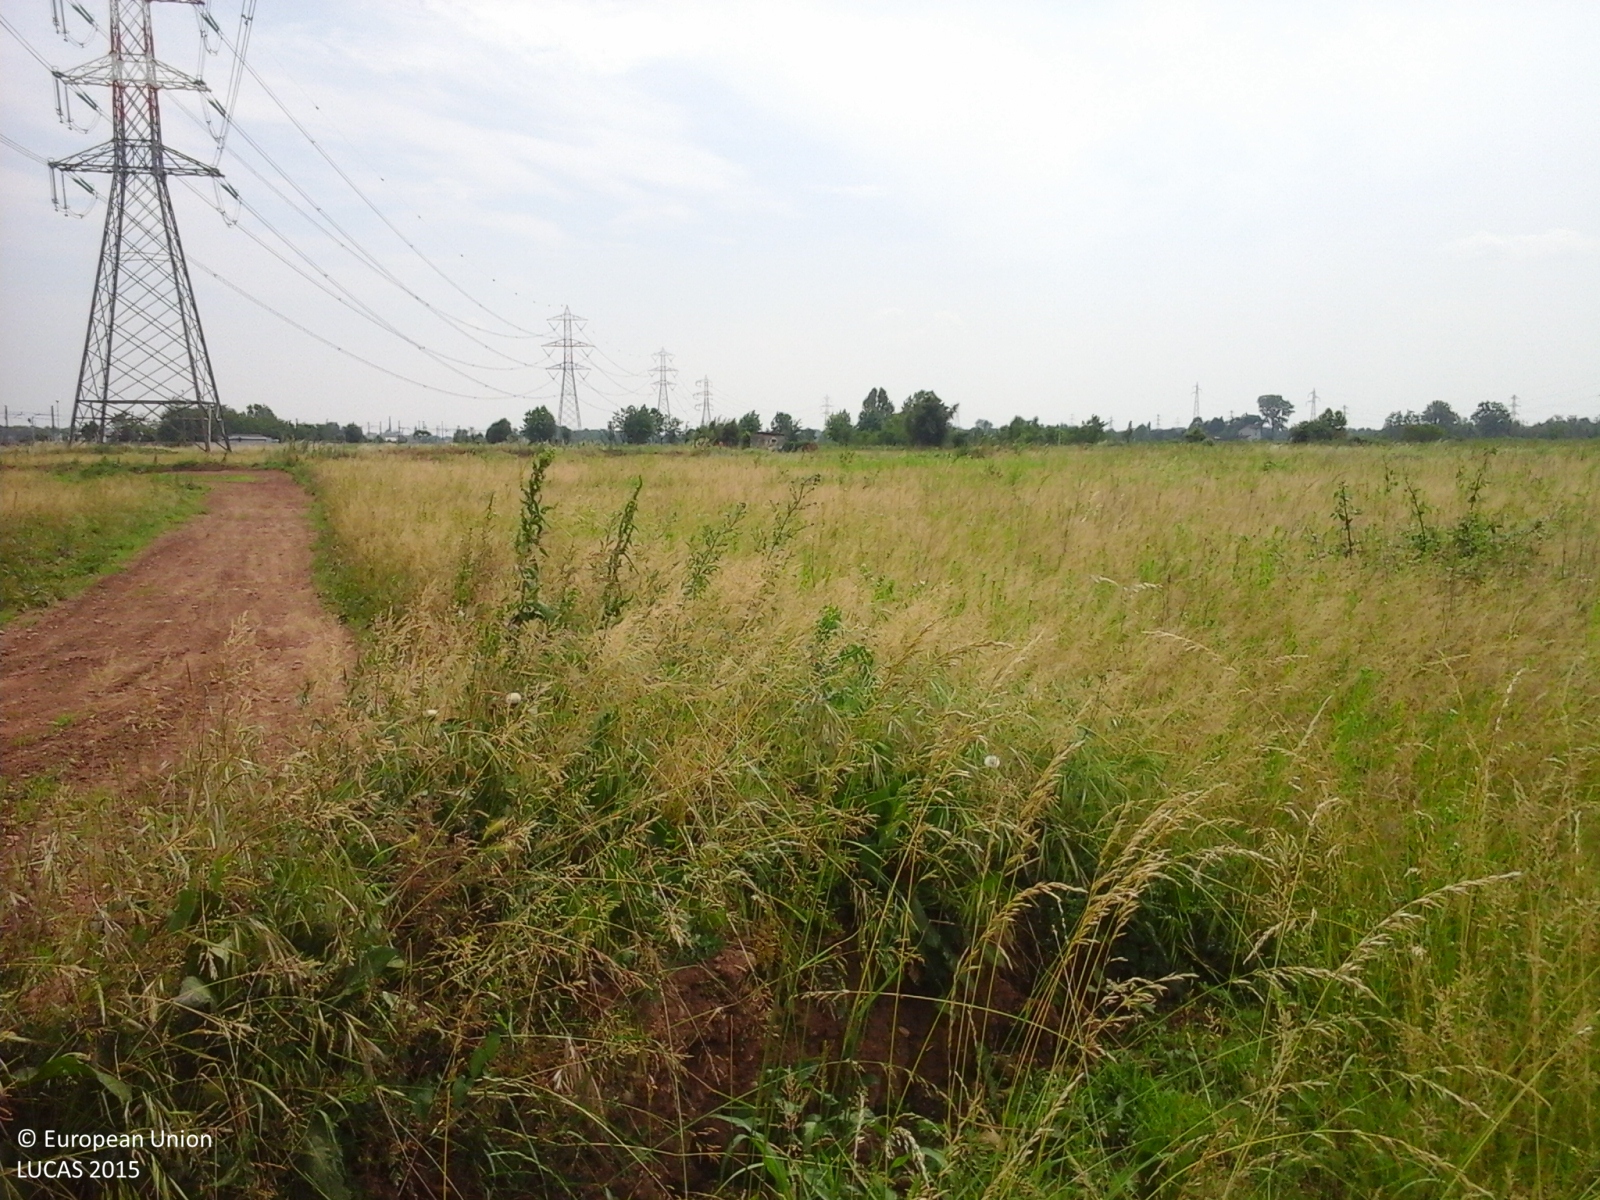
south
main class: Artificial land
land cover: Other artificial areas
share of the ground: > 75 %
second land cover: Spontaneously vegetated surfaces
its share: > 75 %
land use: Electricity, gas and thermal power distribution
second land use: Sport
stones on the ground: > 50 %
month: May
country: IT
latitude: 45.5757
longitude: 9.6034
